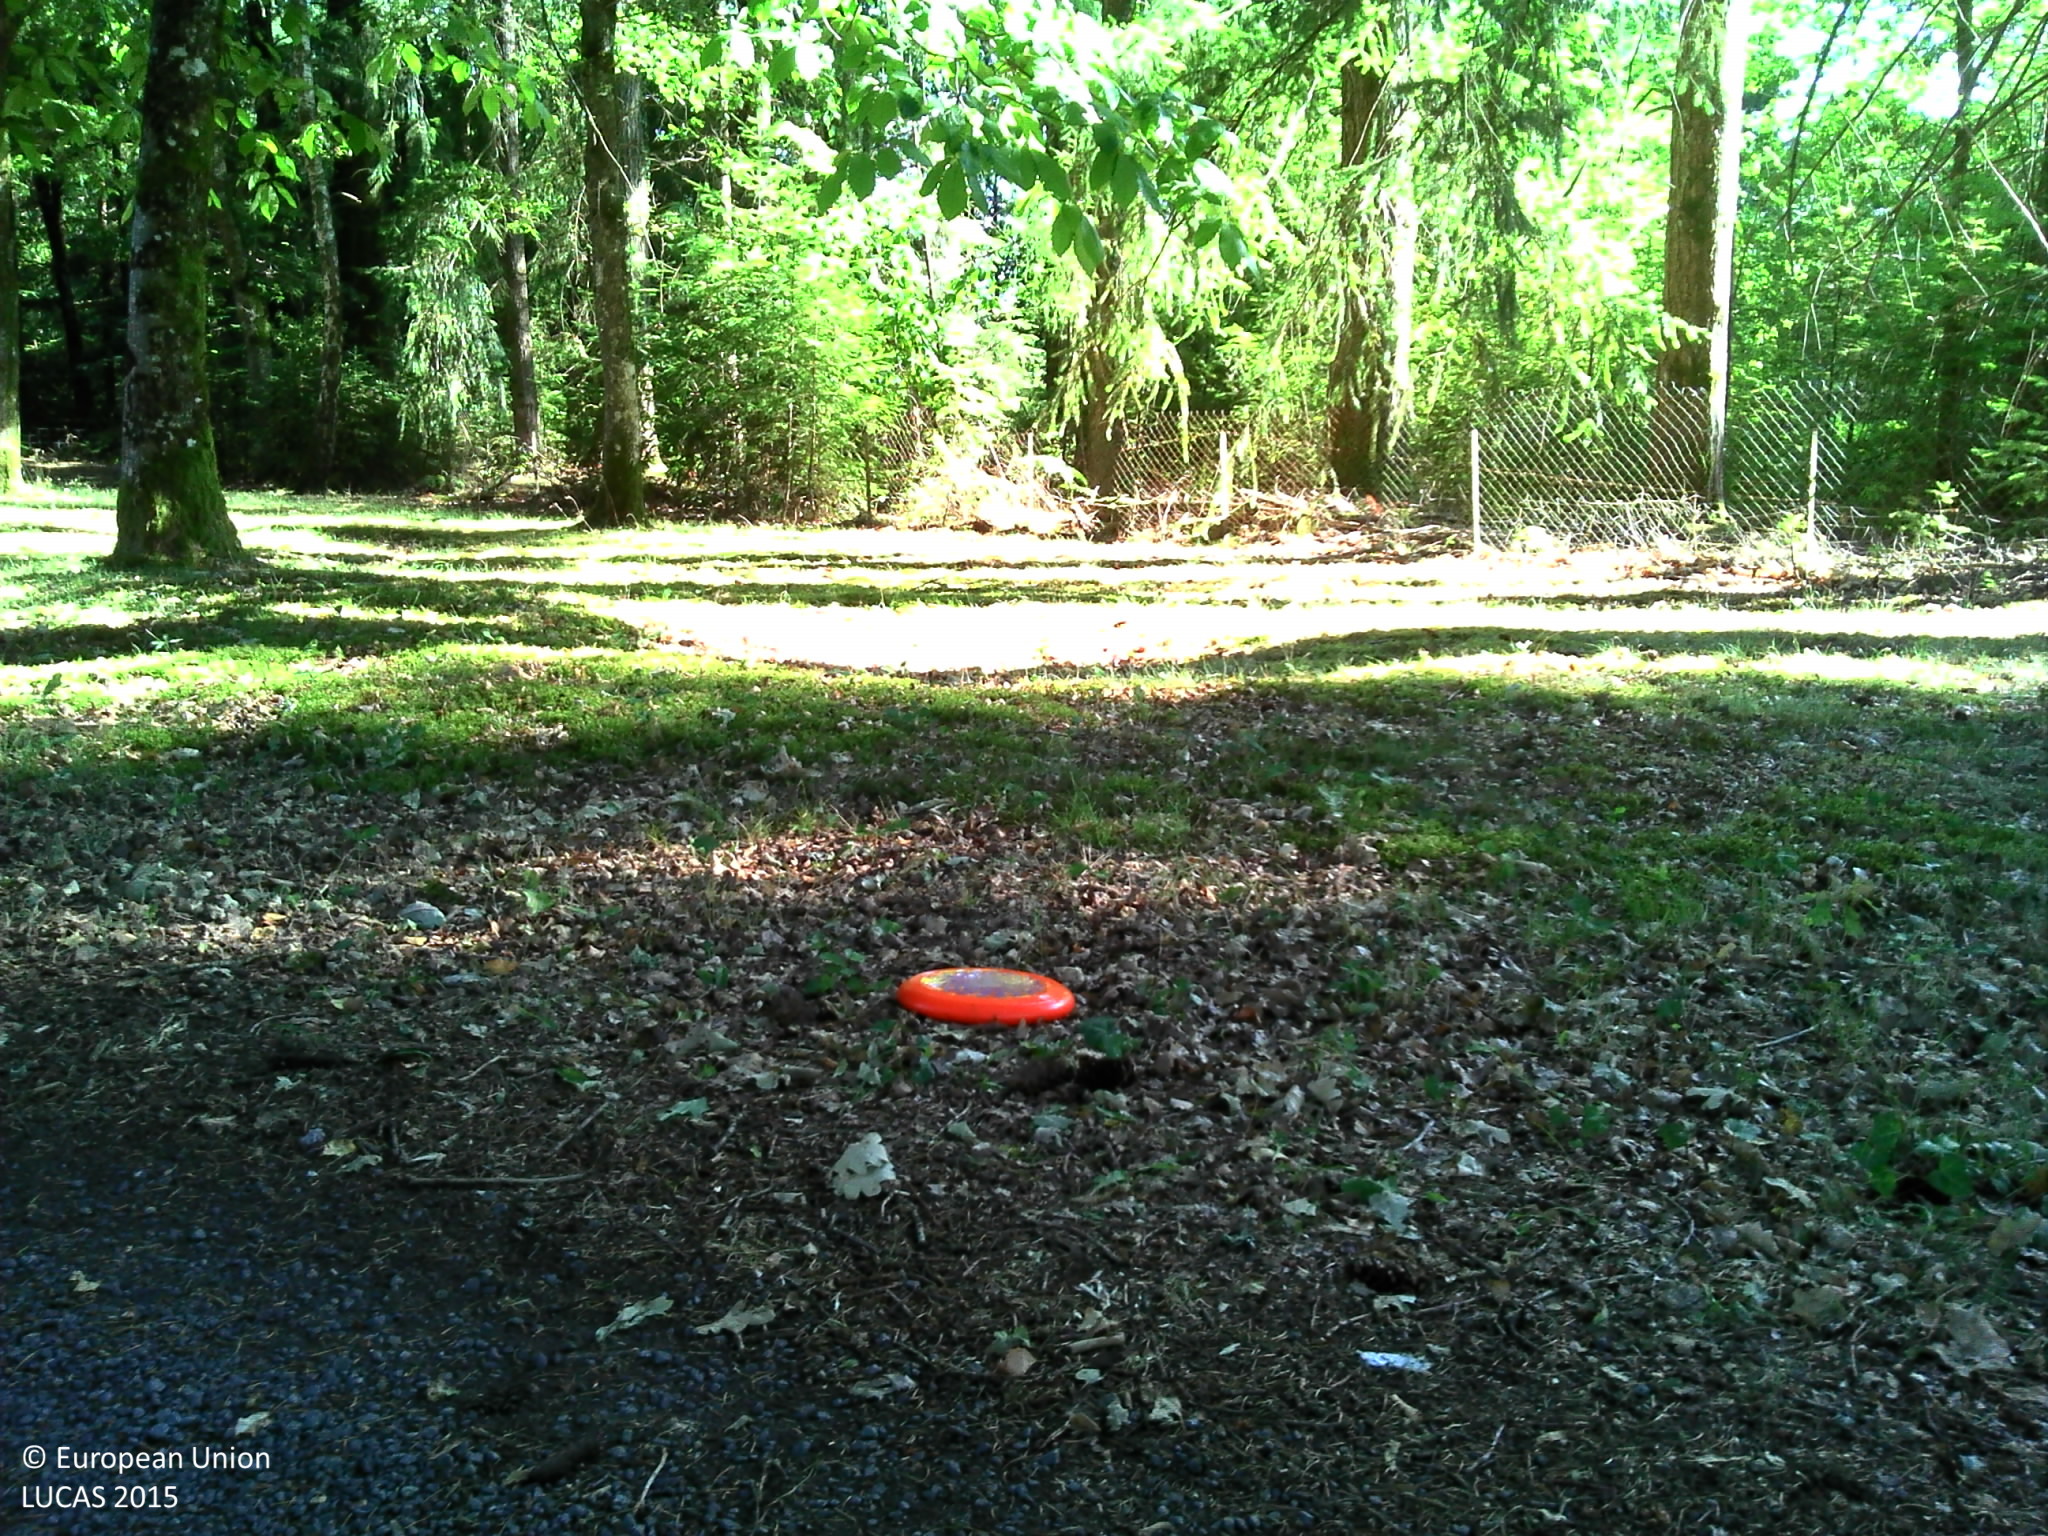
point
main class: Woodland
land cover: Broadleaved woodland
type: acidophilous oak and oak-birch forest
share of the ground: > 75 %
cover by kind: broadleaved forest trees 50 %, lichens and mosses 30 %, herbaceous plants 10 %, unconsolidated bare surface 10 %
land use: Residential
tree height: > 5 m
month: July
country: FR
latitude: 45.8255
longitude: 0.9915
